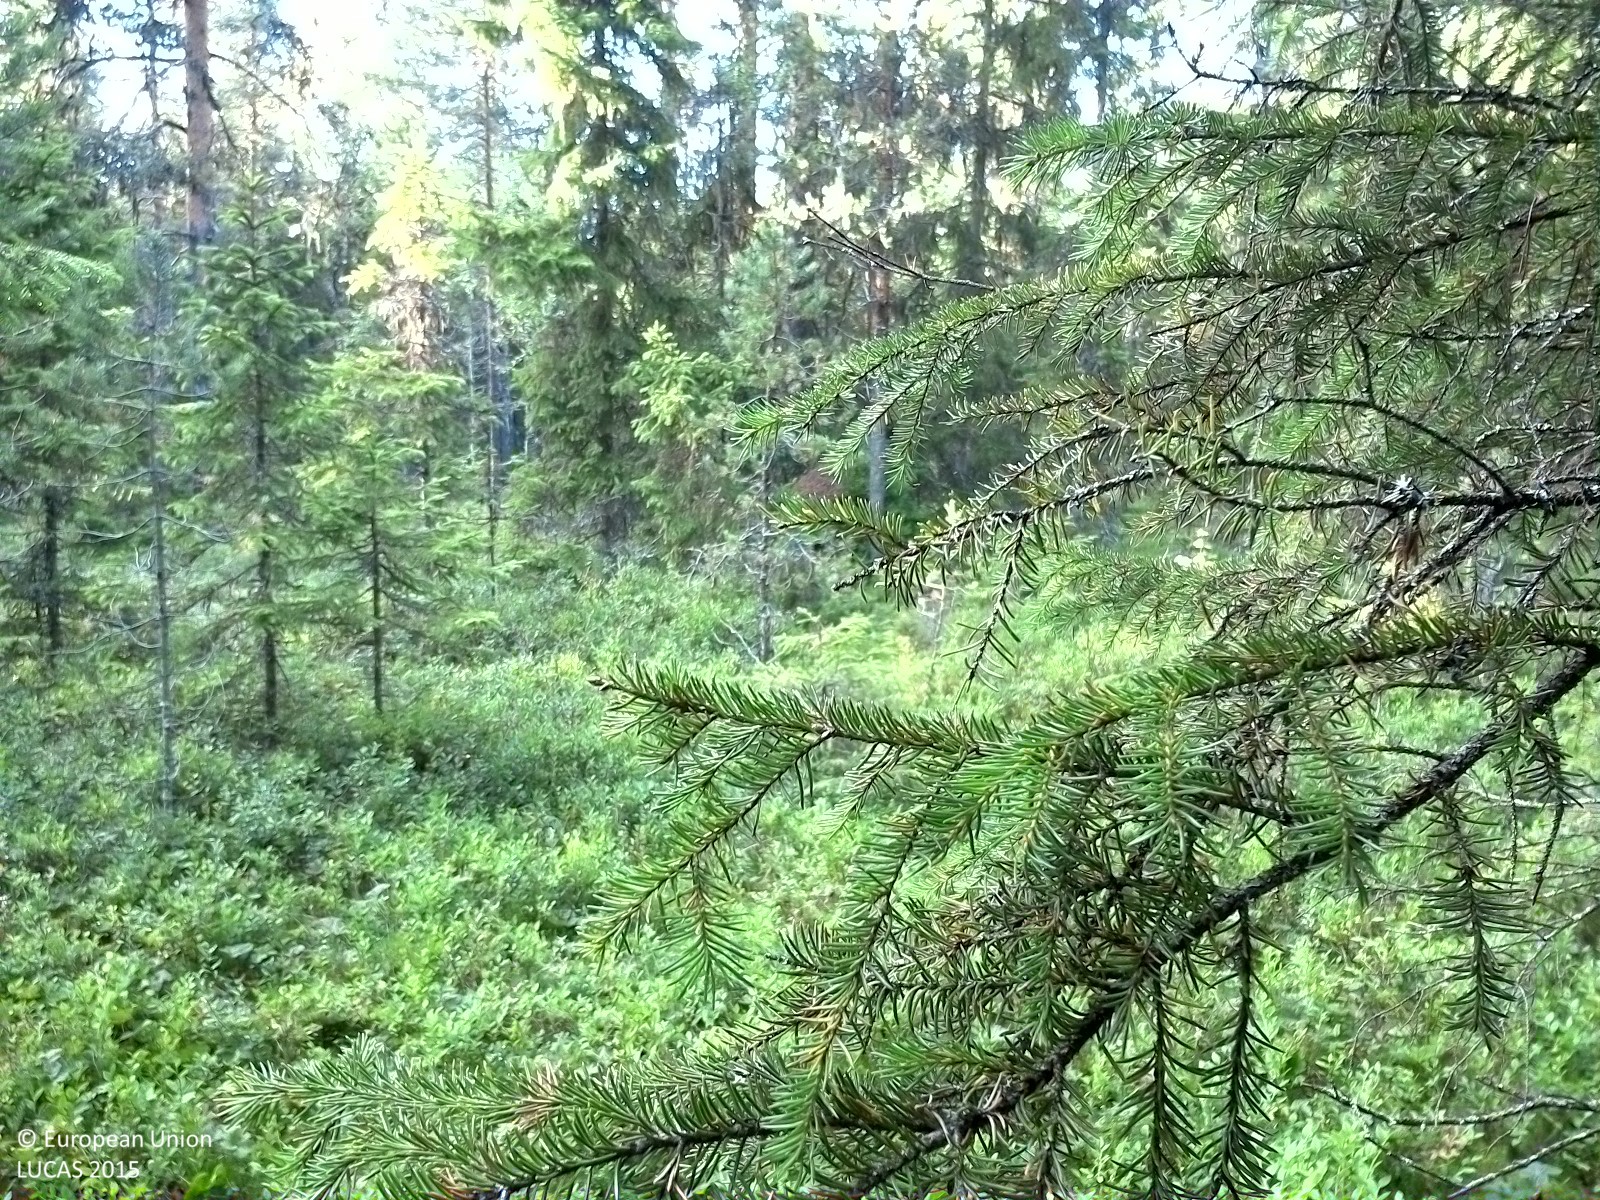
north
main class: Woodland
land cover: Spruce dominated mixed woodland
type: boreal forest
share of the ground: > 75 %
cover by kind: coniferous forest trees 55 %, broadleaved forest trees 20 %, shrubs 20 %, lichens and mosses 5 %
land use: Forestry
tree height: > 5 m
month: August
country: SE
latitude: 62.3409
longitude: 16.1784
